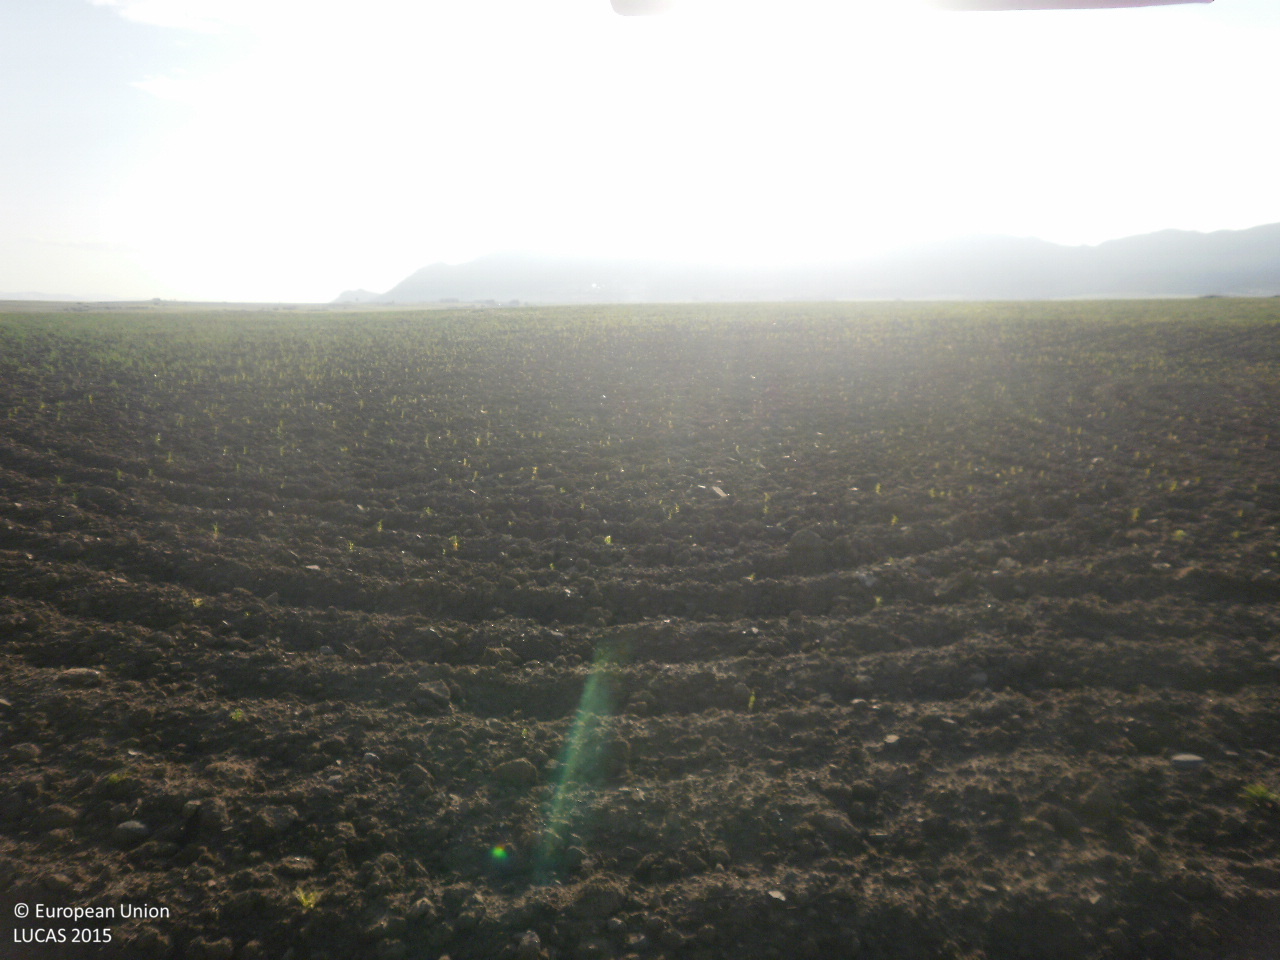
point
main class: Cropland
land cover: Dry pulses
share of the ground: > 75 %
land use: Agriculture (excluding fallow land and kitchen gardens)
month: April
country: ES
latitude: 38.7996
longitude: -5.1998
